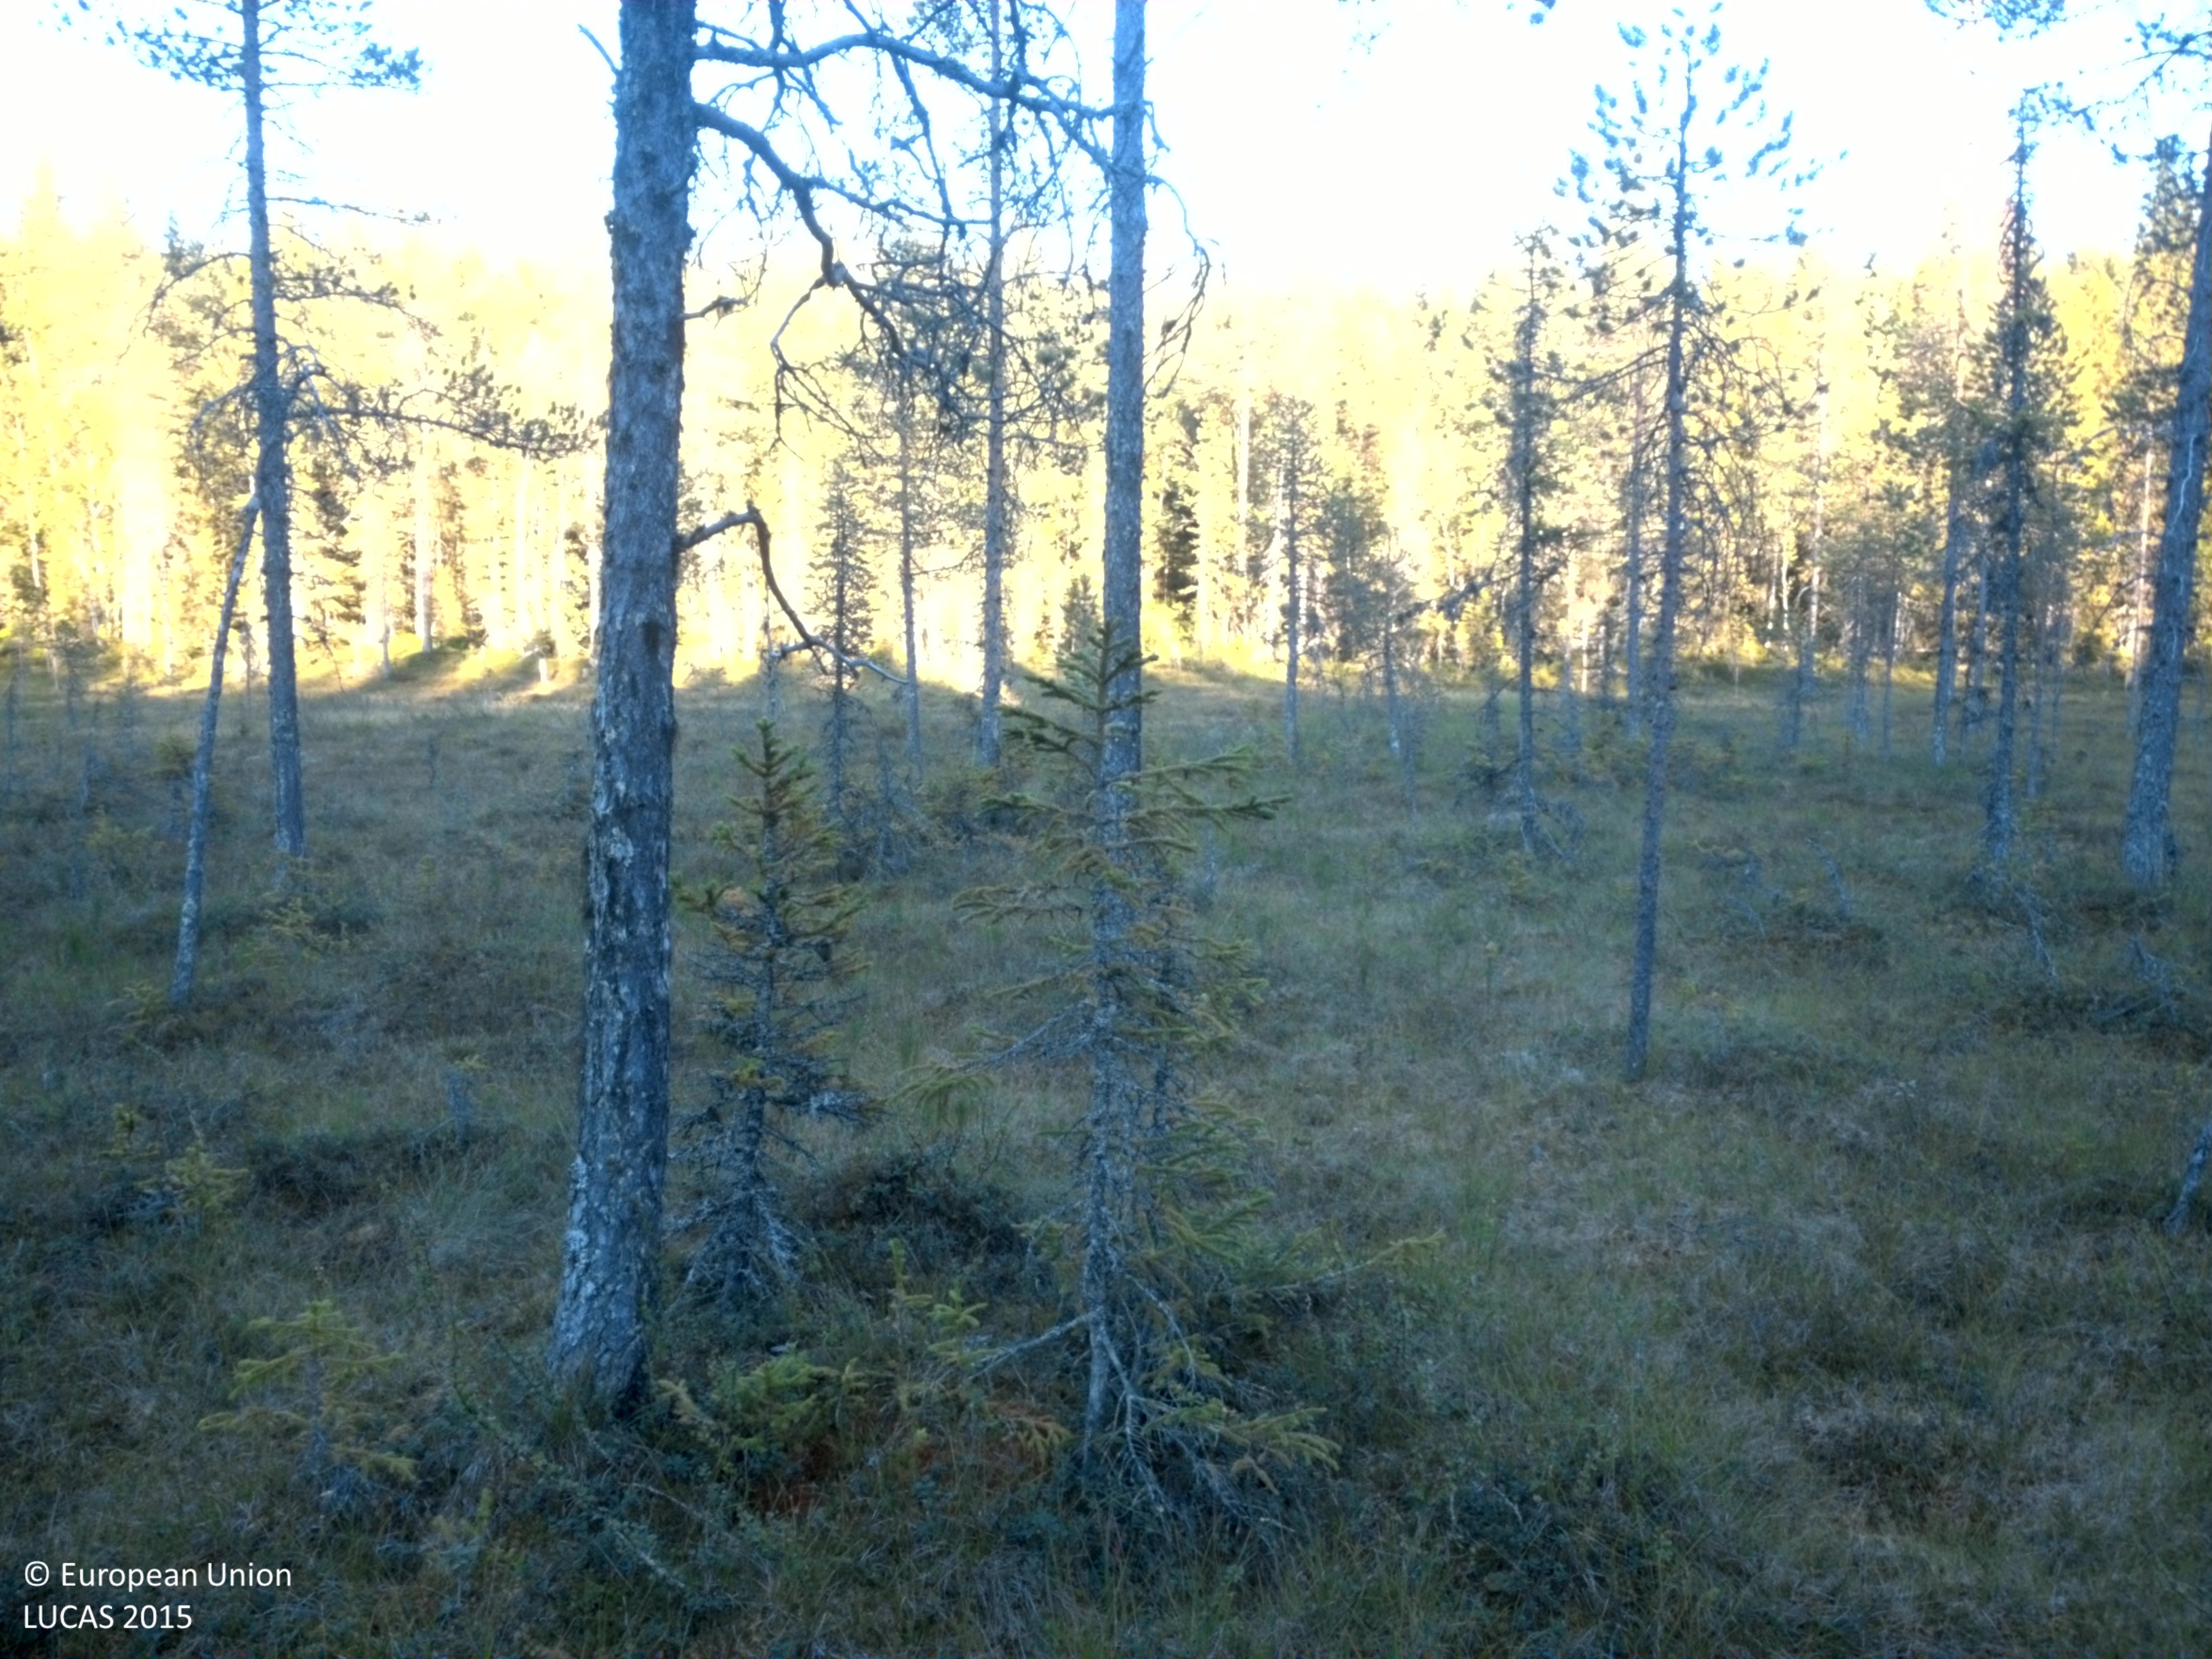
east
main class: Woodland
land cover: Pine dominated coniferous woodland
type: boreal forest
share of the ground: 25 - 50 %
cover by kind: coniferous forest trees 35 %, lichens and mosses 30 %, herbaceous plants 20 %, shrubs 15 %
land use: Forestry
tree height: > 5 m
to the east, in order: Pine dominated coniferous woodland; Spruce dominated mixed woodland; Pine dominated coniferous woodland
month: August
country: SE
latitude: 64.4514
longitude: 18.6767
